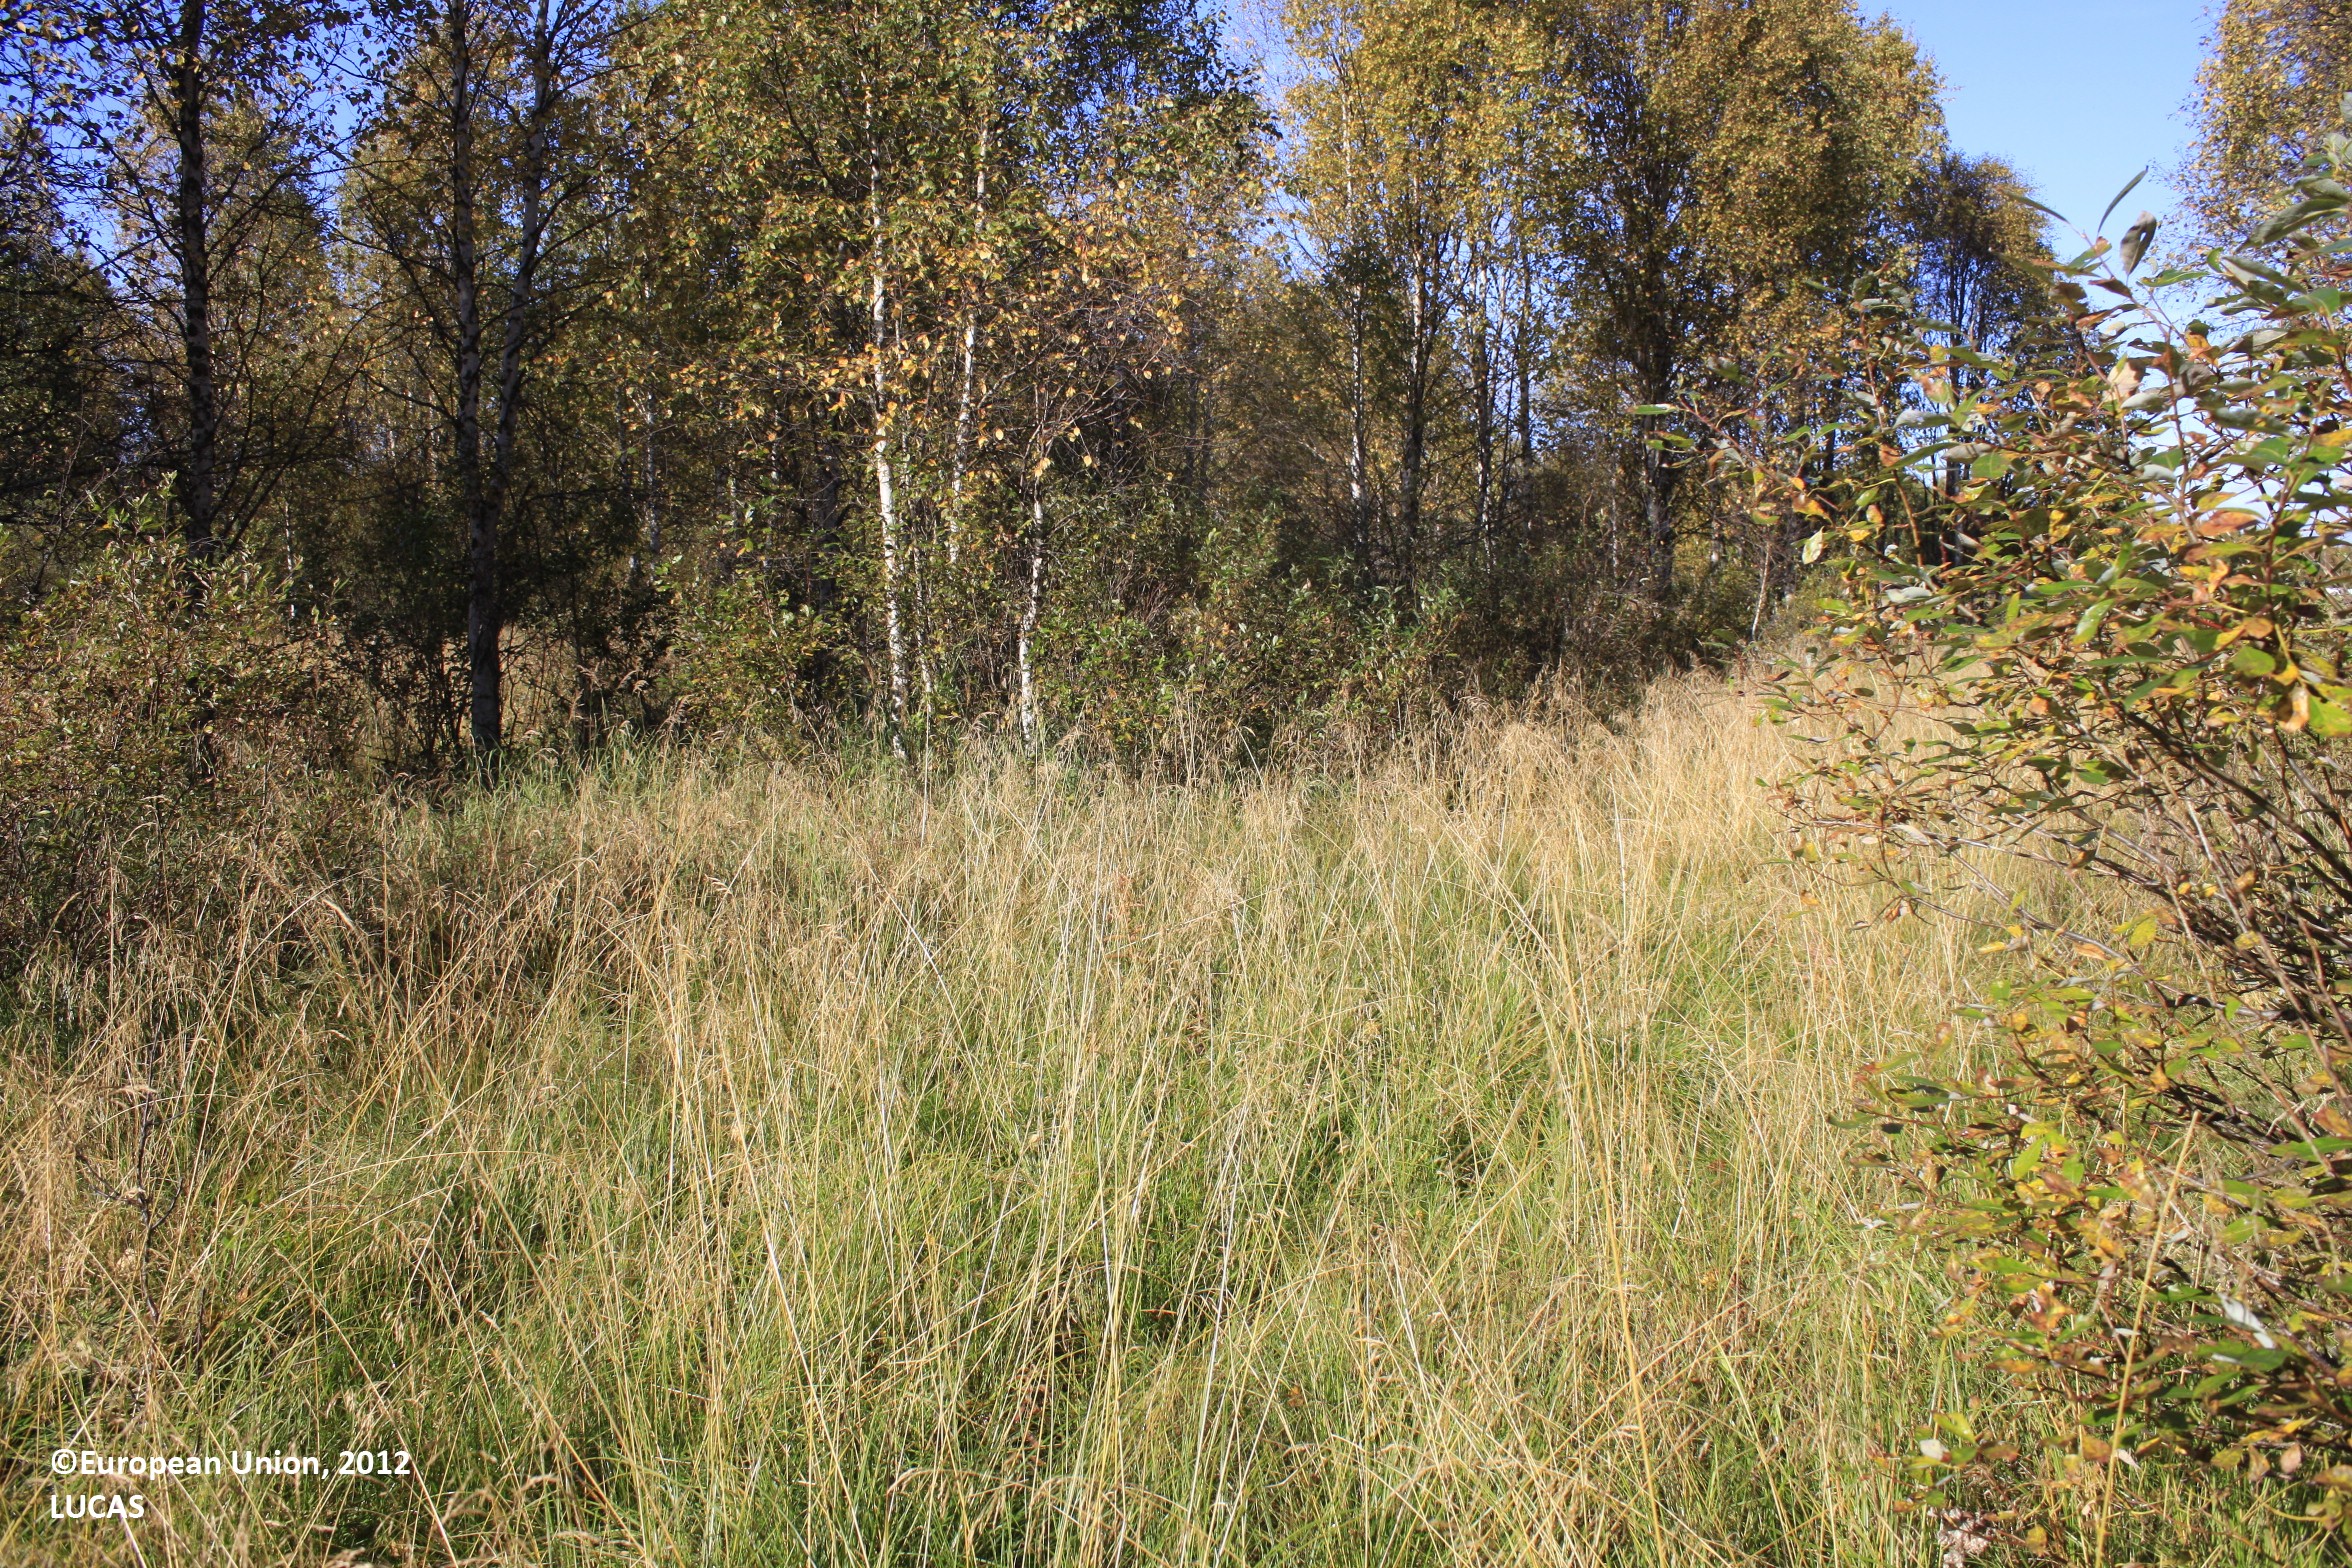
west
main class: Woodland
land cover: Broadleaved woodland
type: boreal forest
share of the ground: 50 - 75 %
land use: Forestry
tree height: > 5 m
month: September
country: FI
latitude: 65.6147
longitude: 26.5770
